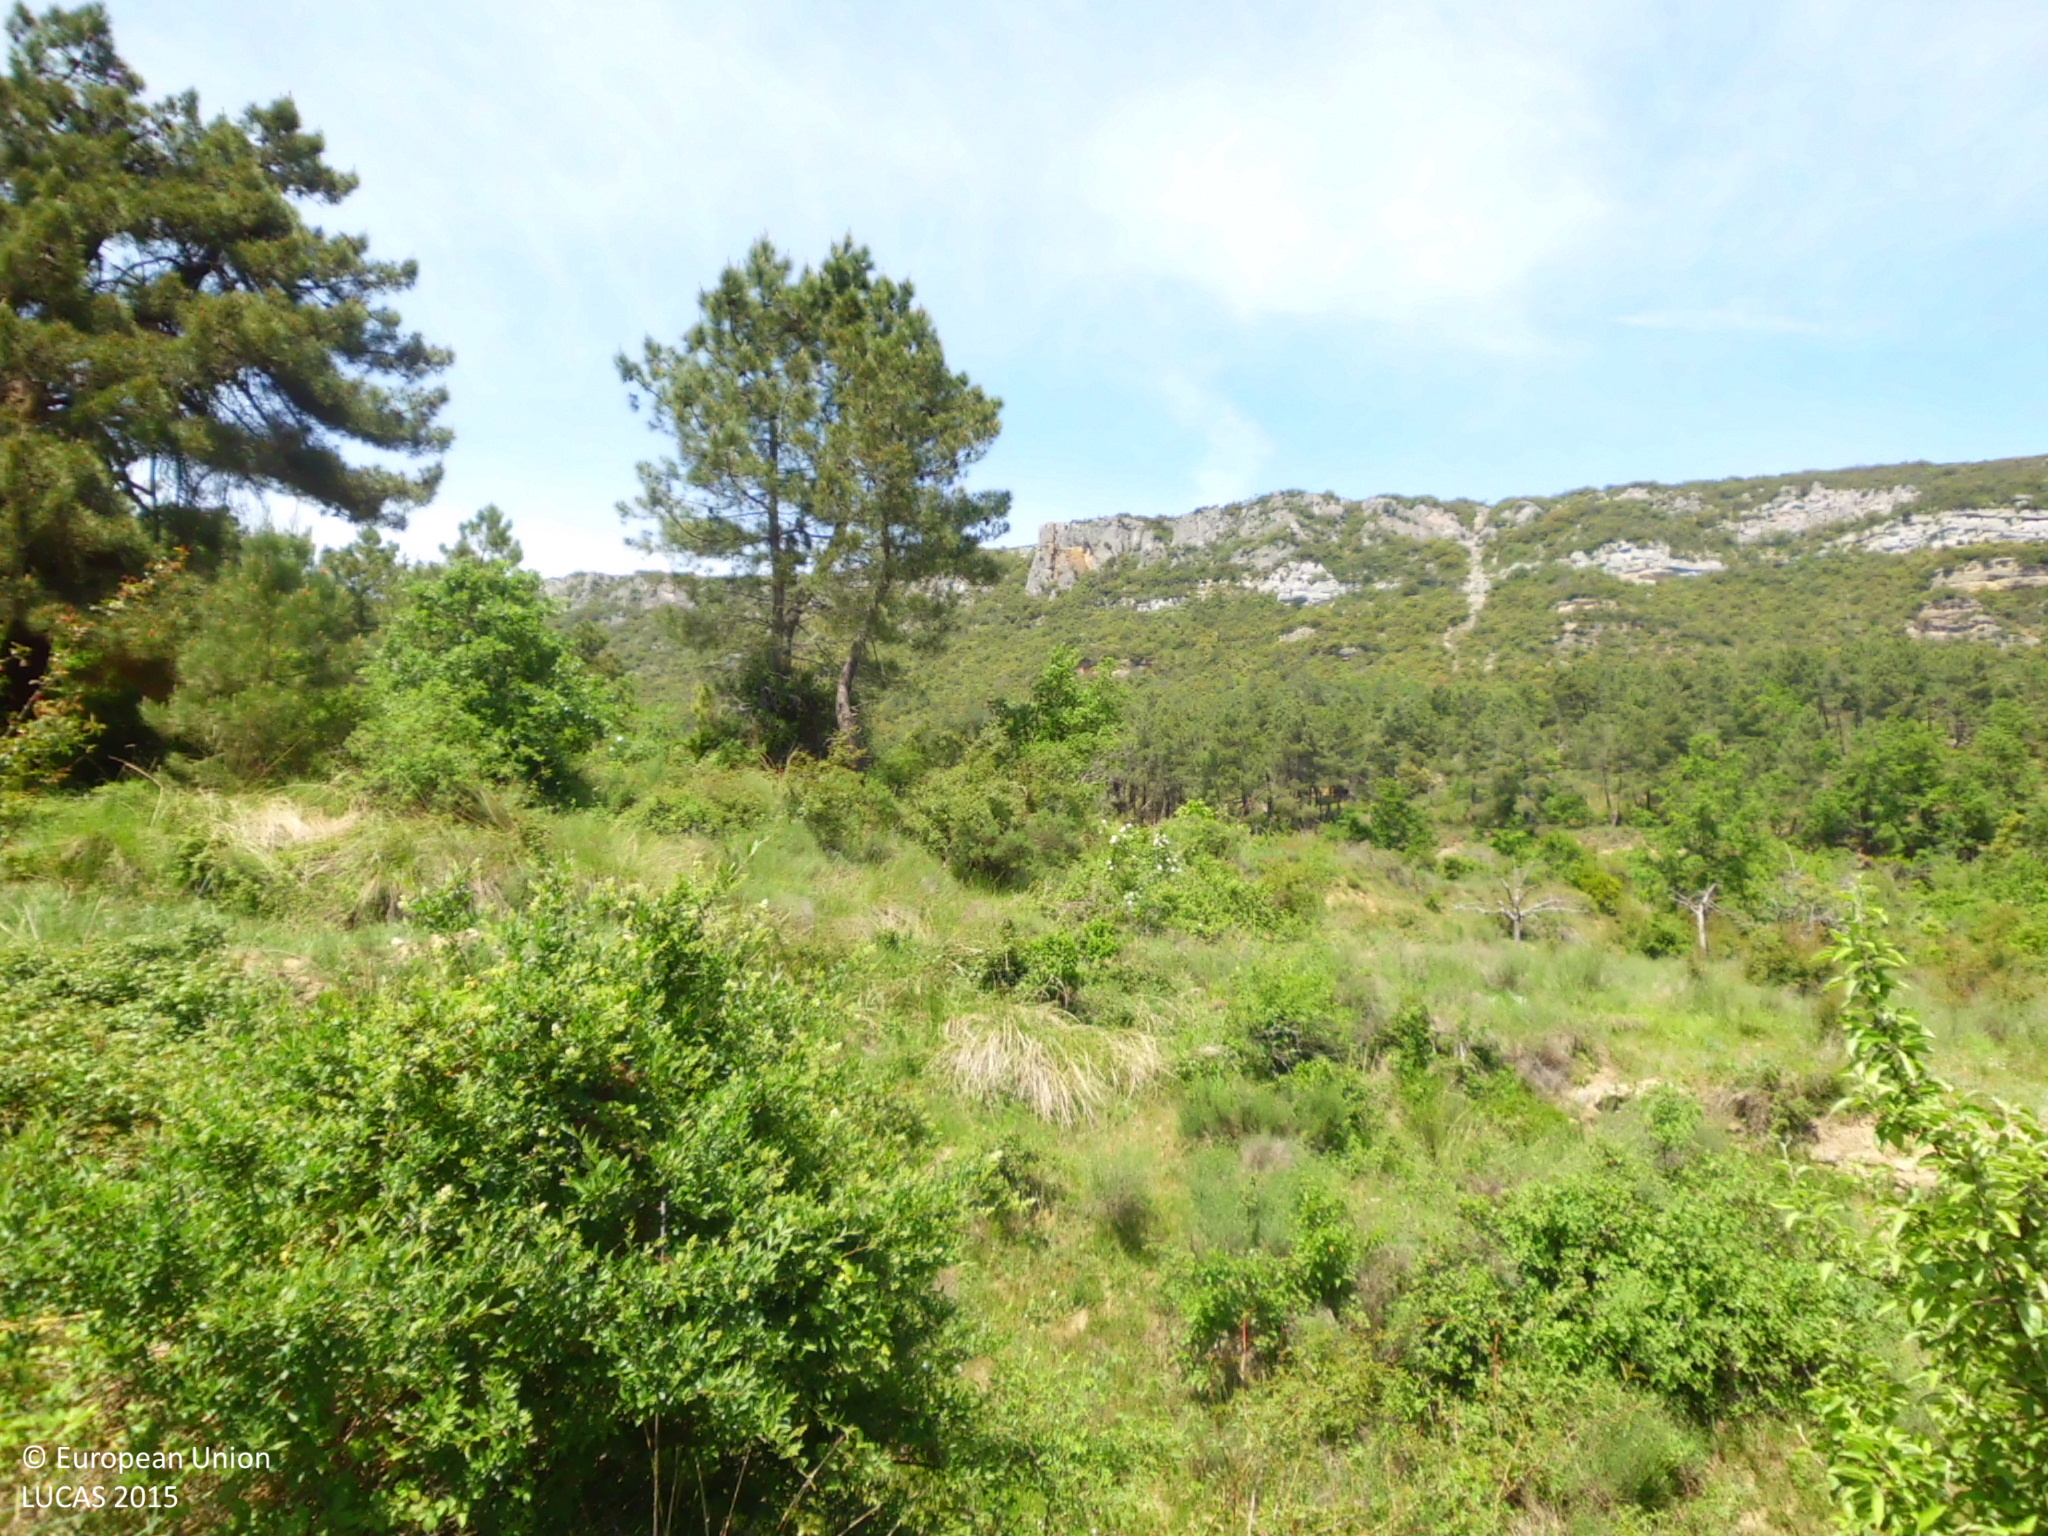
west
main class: Shrubland
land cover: Shrubland with sparse tree cover
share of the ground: 25 - 50 %
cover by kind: herbaceous plants 50 %, shrubs 45 %, broadleaved forest trees 5 %
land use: Semi-natural and natural areas not in use
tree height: < 5 m
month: May
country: ES
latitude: 42.7413
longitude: -3.4369
